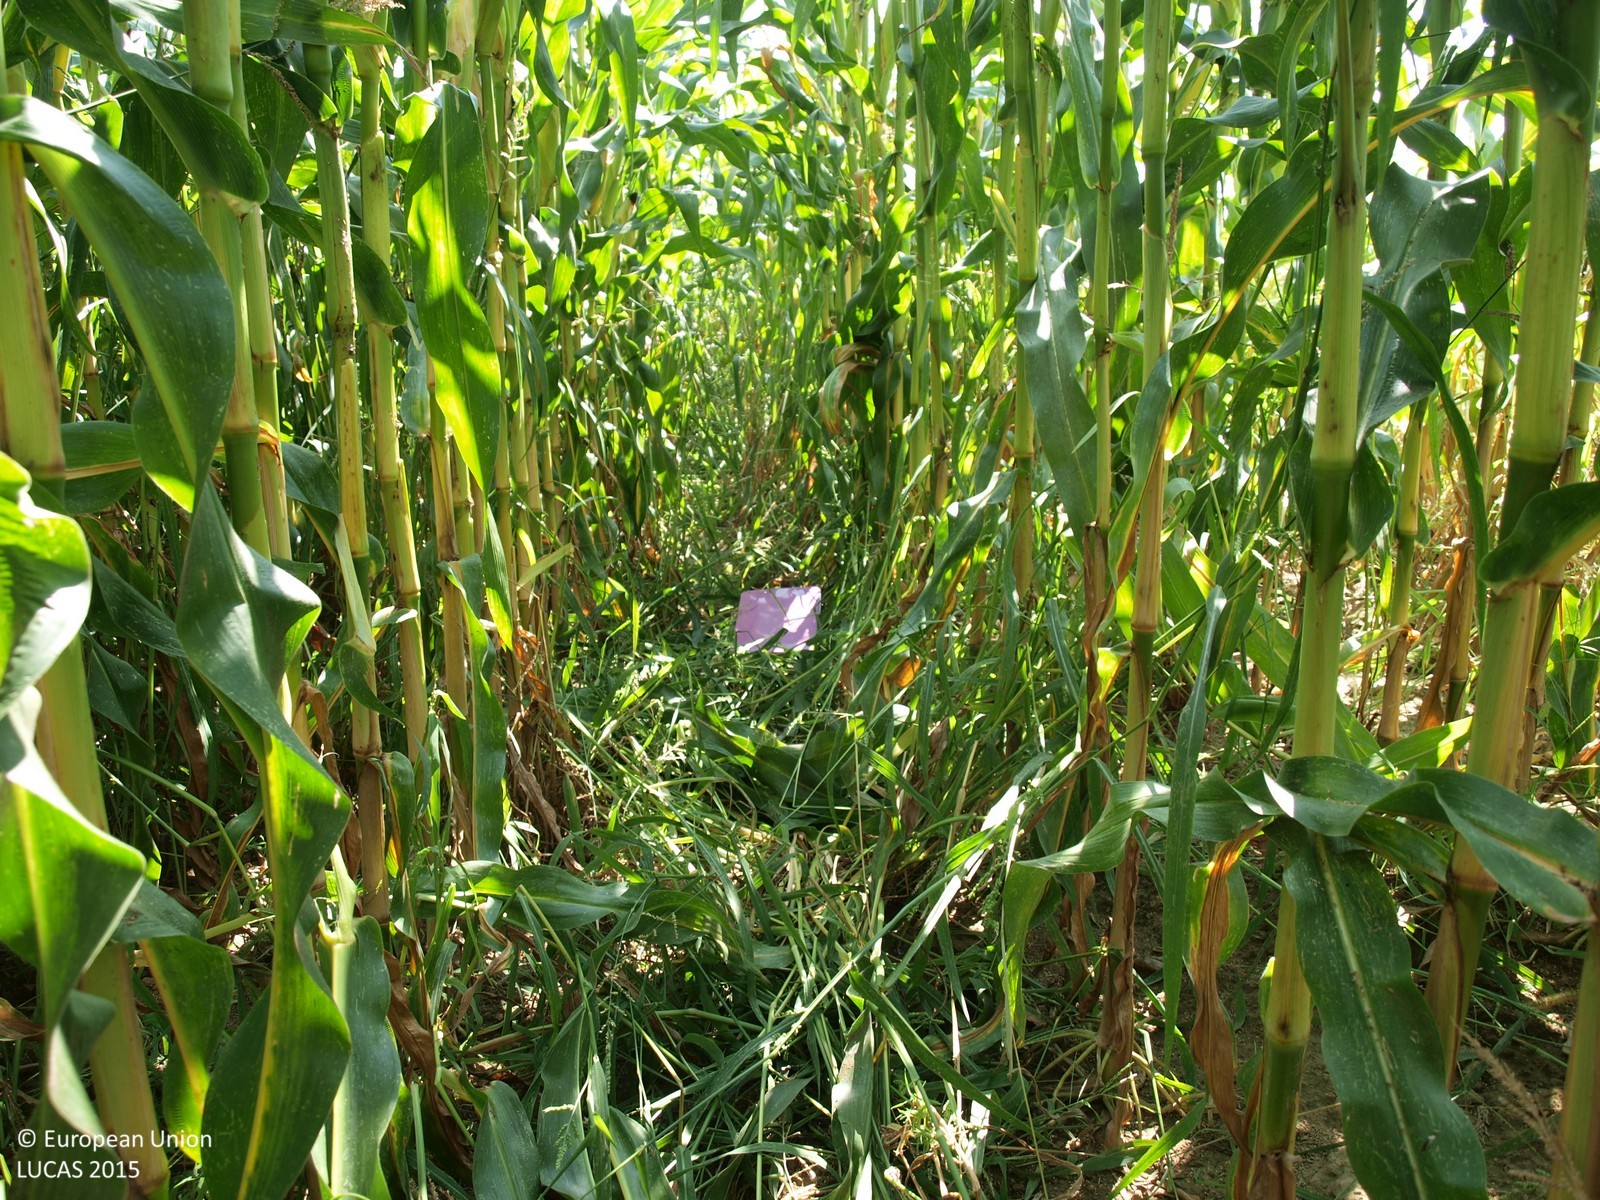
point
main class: Cropland
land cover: Maize
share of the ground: > 75 %
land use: Agriculture (excluding fallow land and kitchen gardens)
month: August
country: HR
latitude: 46.0793
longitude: 16.5301
